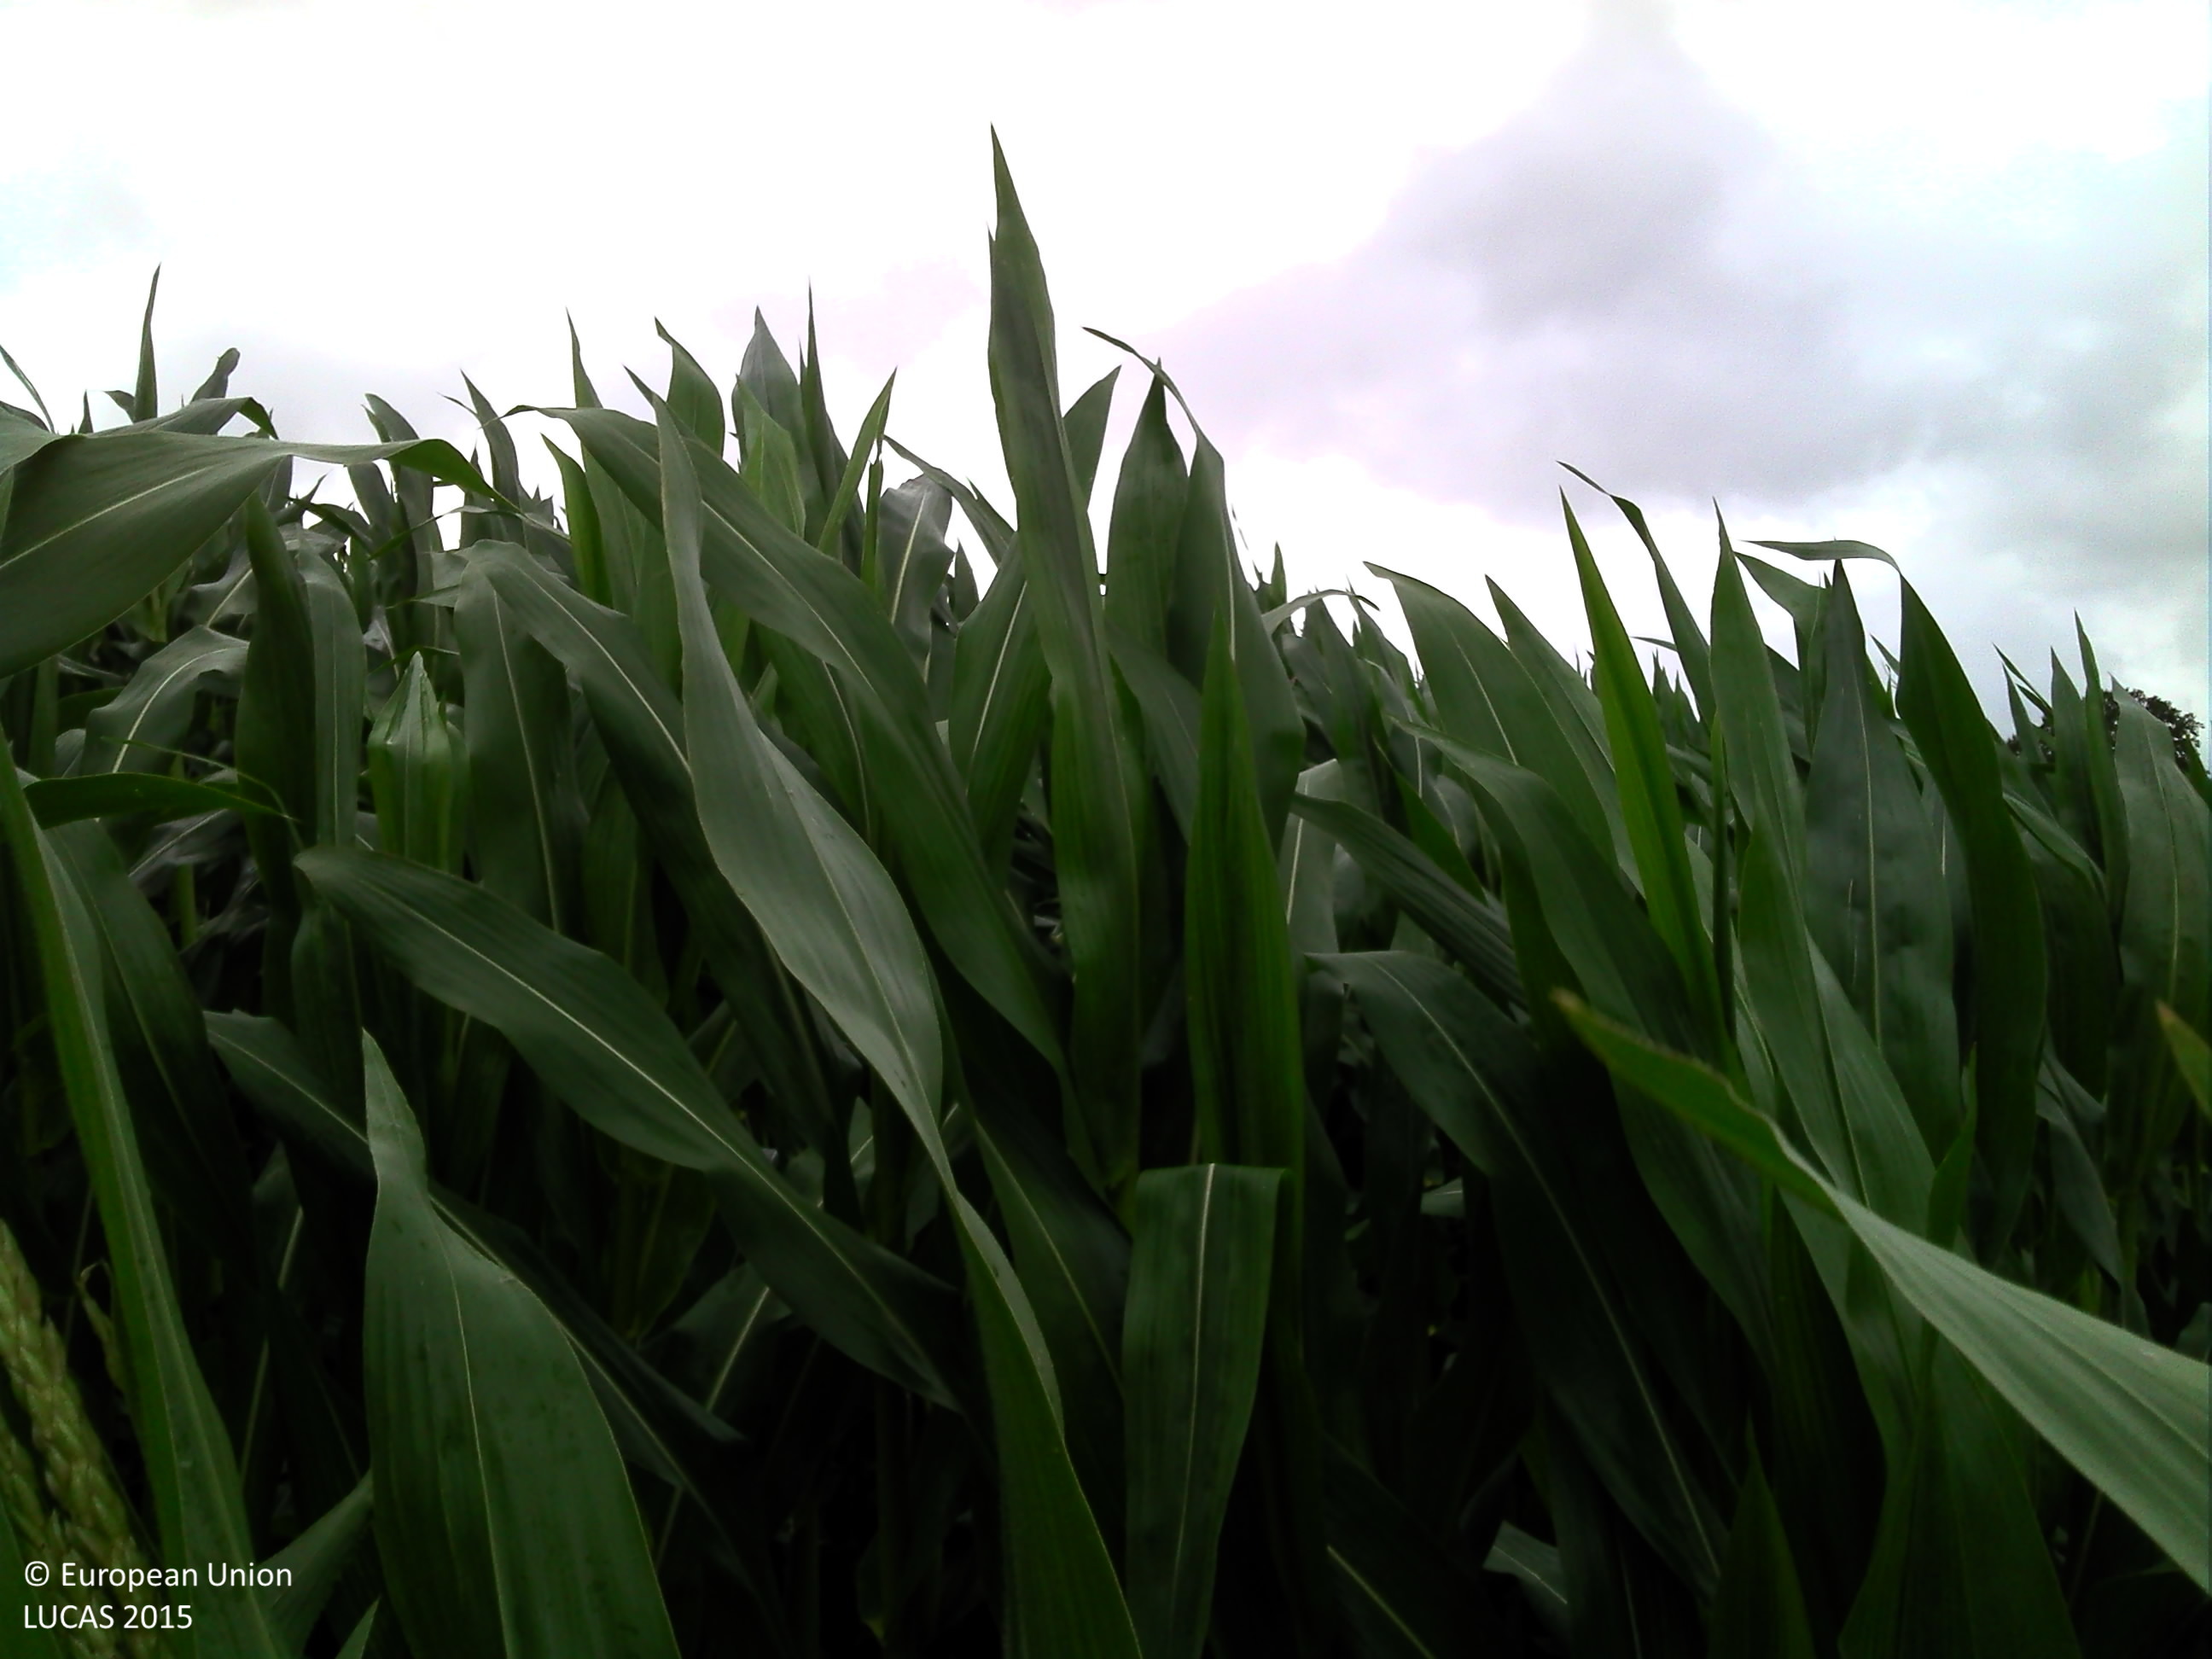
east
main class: Cropland
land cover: Maize
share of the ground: > 75 %
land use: Agriculture (excluding fallow land and kitchen gardens)
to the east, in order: Maize; Ditches and canals; Lines of trees; Ditches and canals; Maize
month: July
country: FR
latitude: 48.0027
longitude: -3.5478
